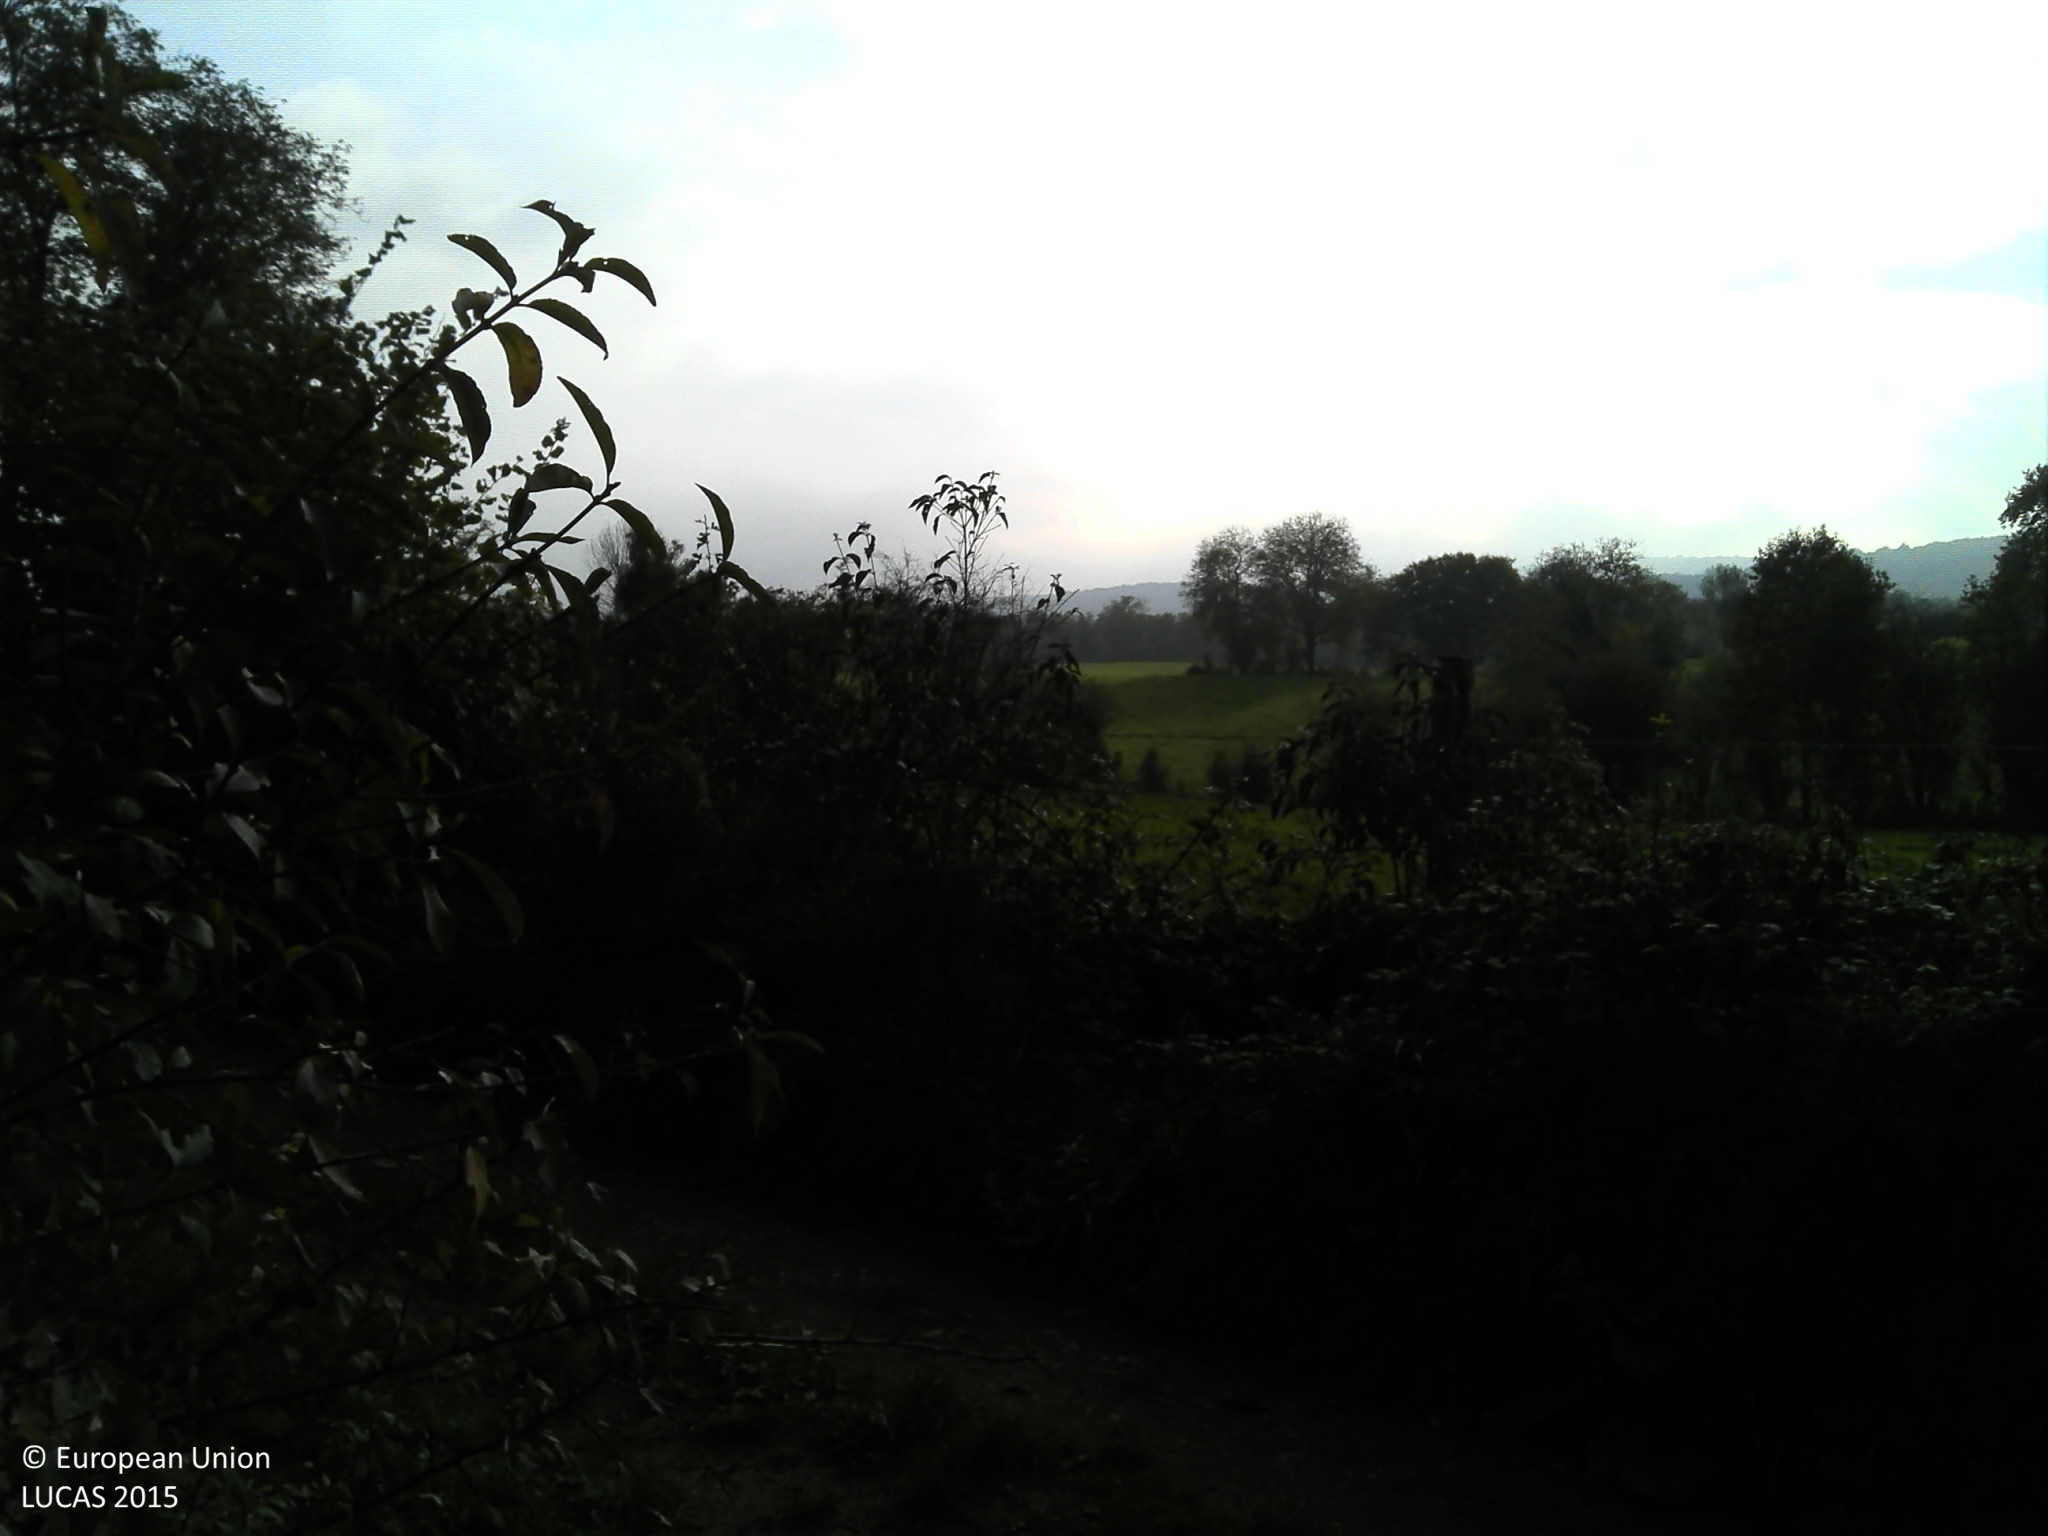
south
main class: Grassland
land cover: Grassland without tree/shrub cover
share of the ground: > 75 %
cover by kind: herbaceous plants 100 %
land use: Agriculture (excluding fallow land and kitchen gardens)
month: October
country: FR
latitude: 46.1433
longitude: 5.3816
